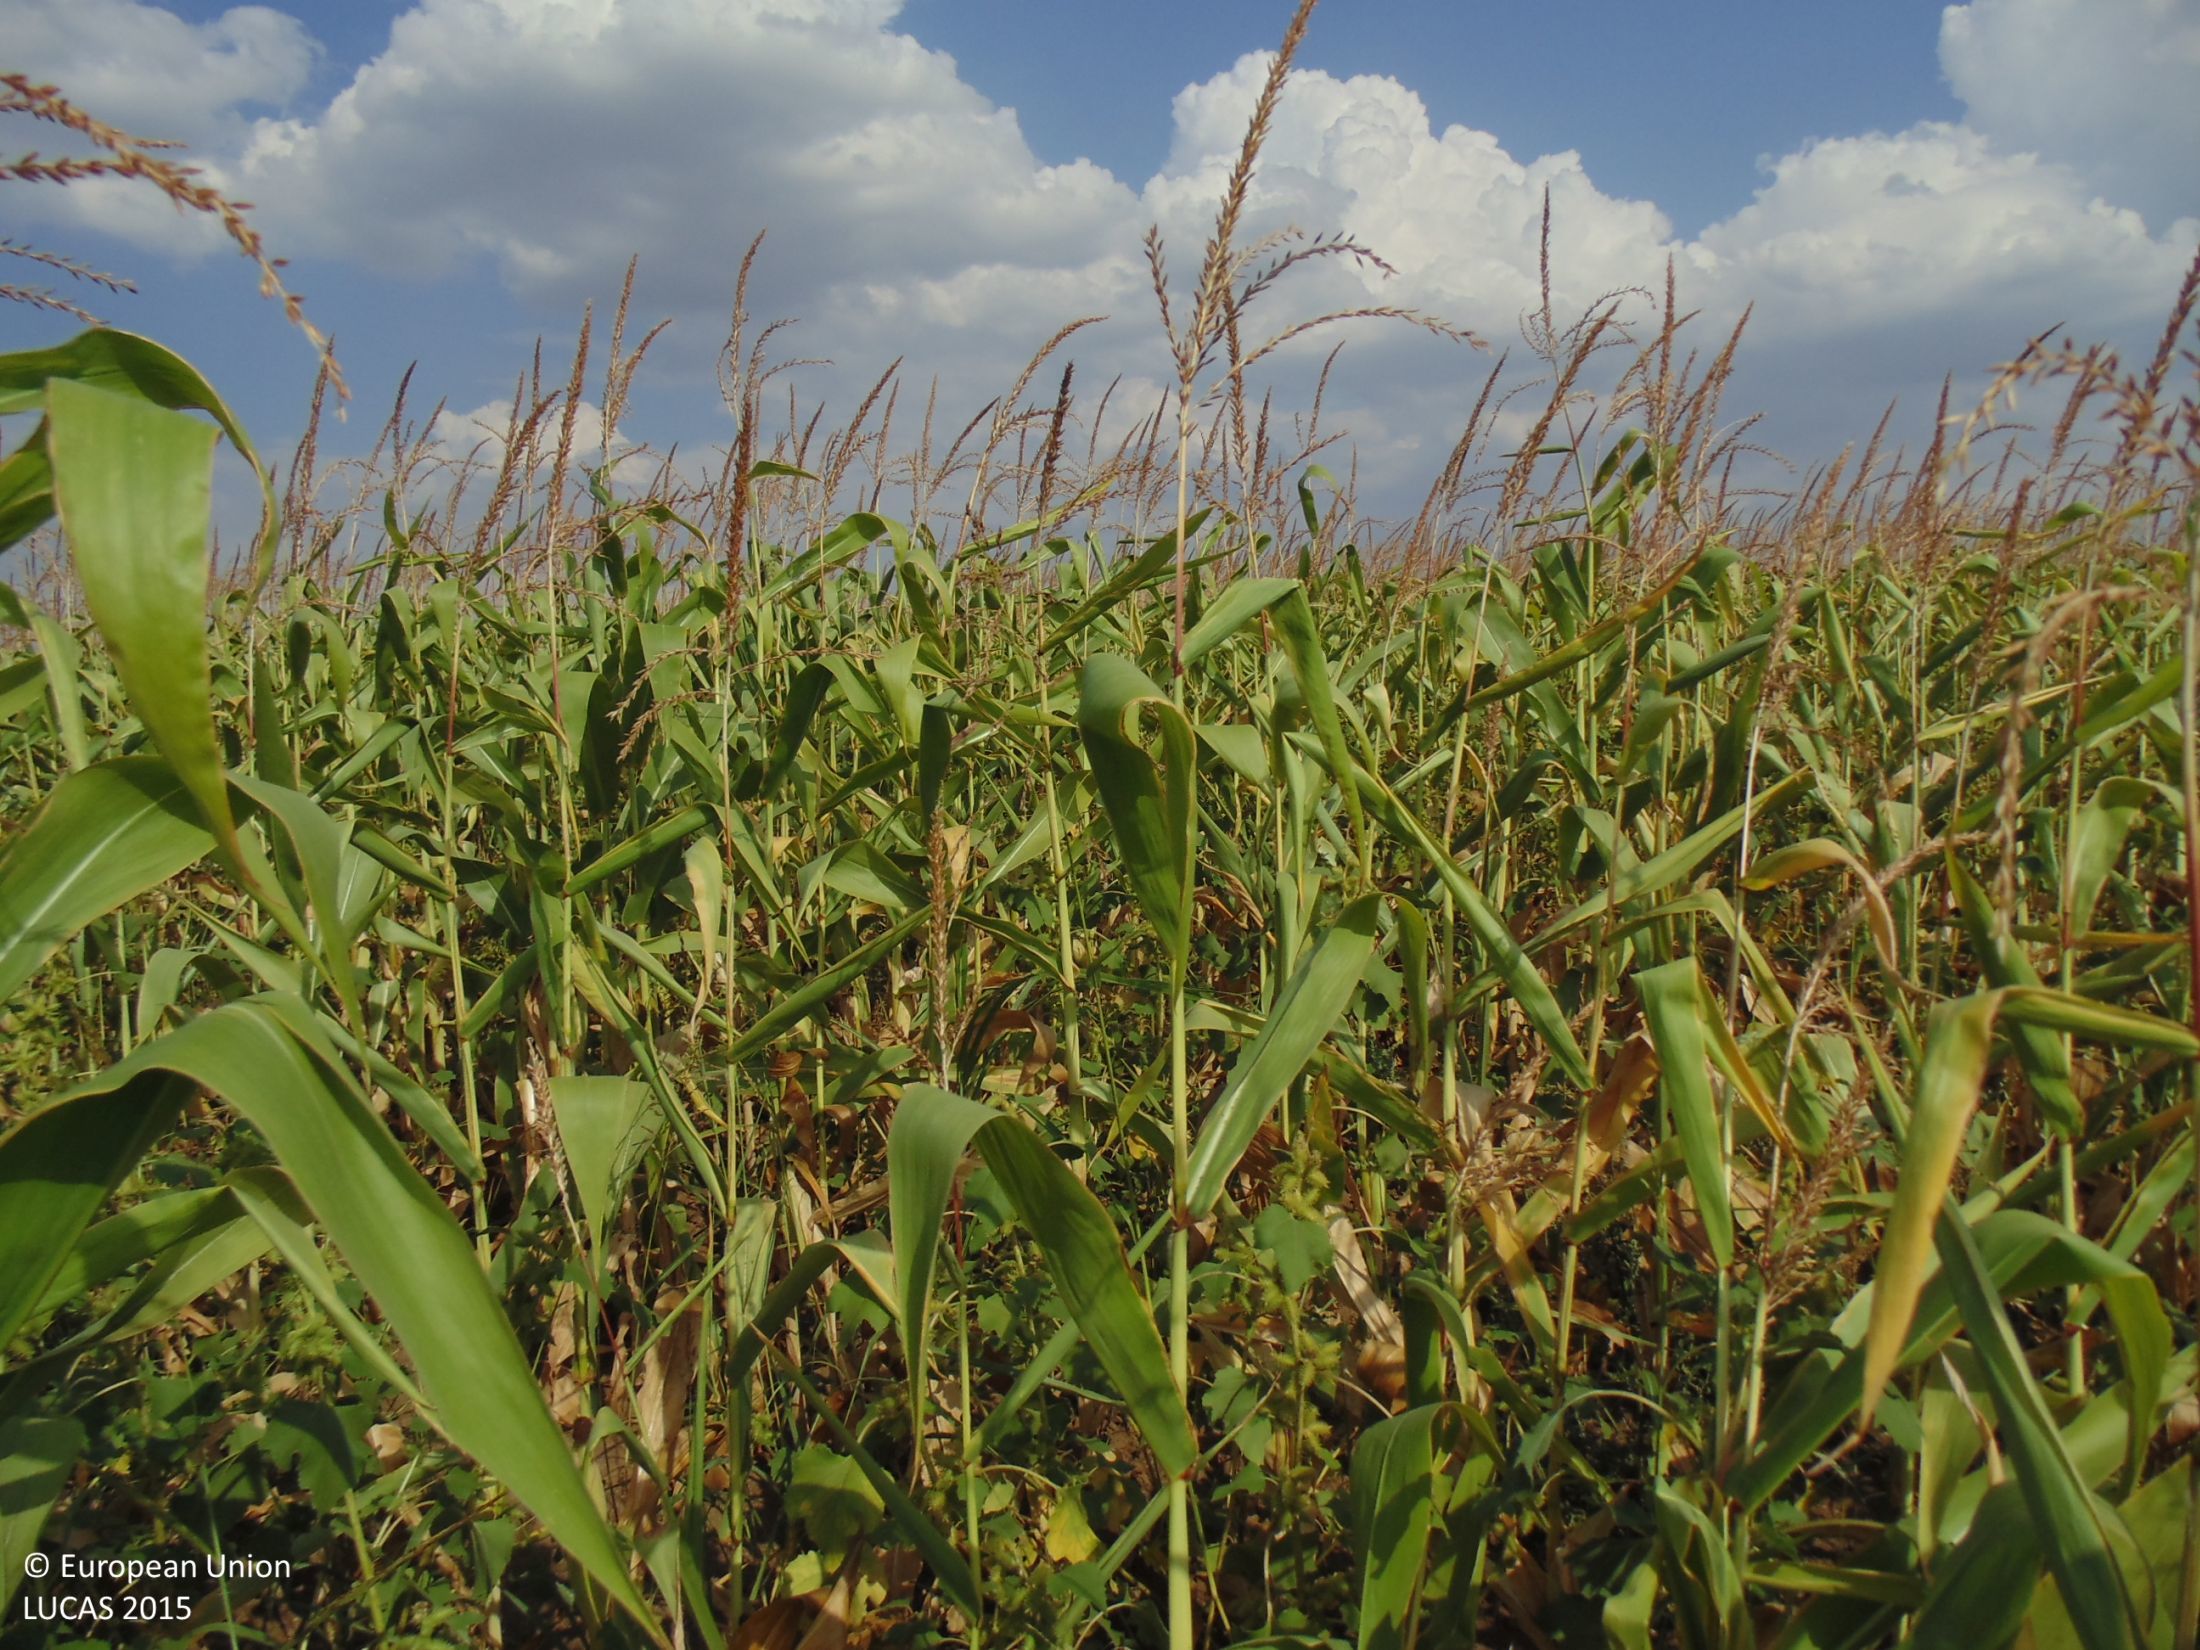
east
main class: Cropland
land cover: Maize
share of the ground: > 75 %
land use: Agriculture (excluding fallow land and kitchen gardens)
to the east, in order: Maize
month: August
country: BG
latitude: 43.8379
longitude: 27.5357
